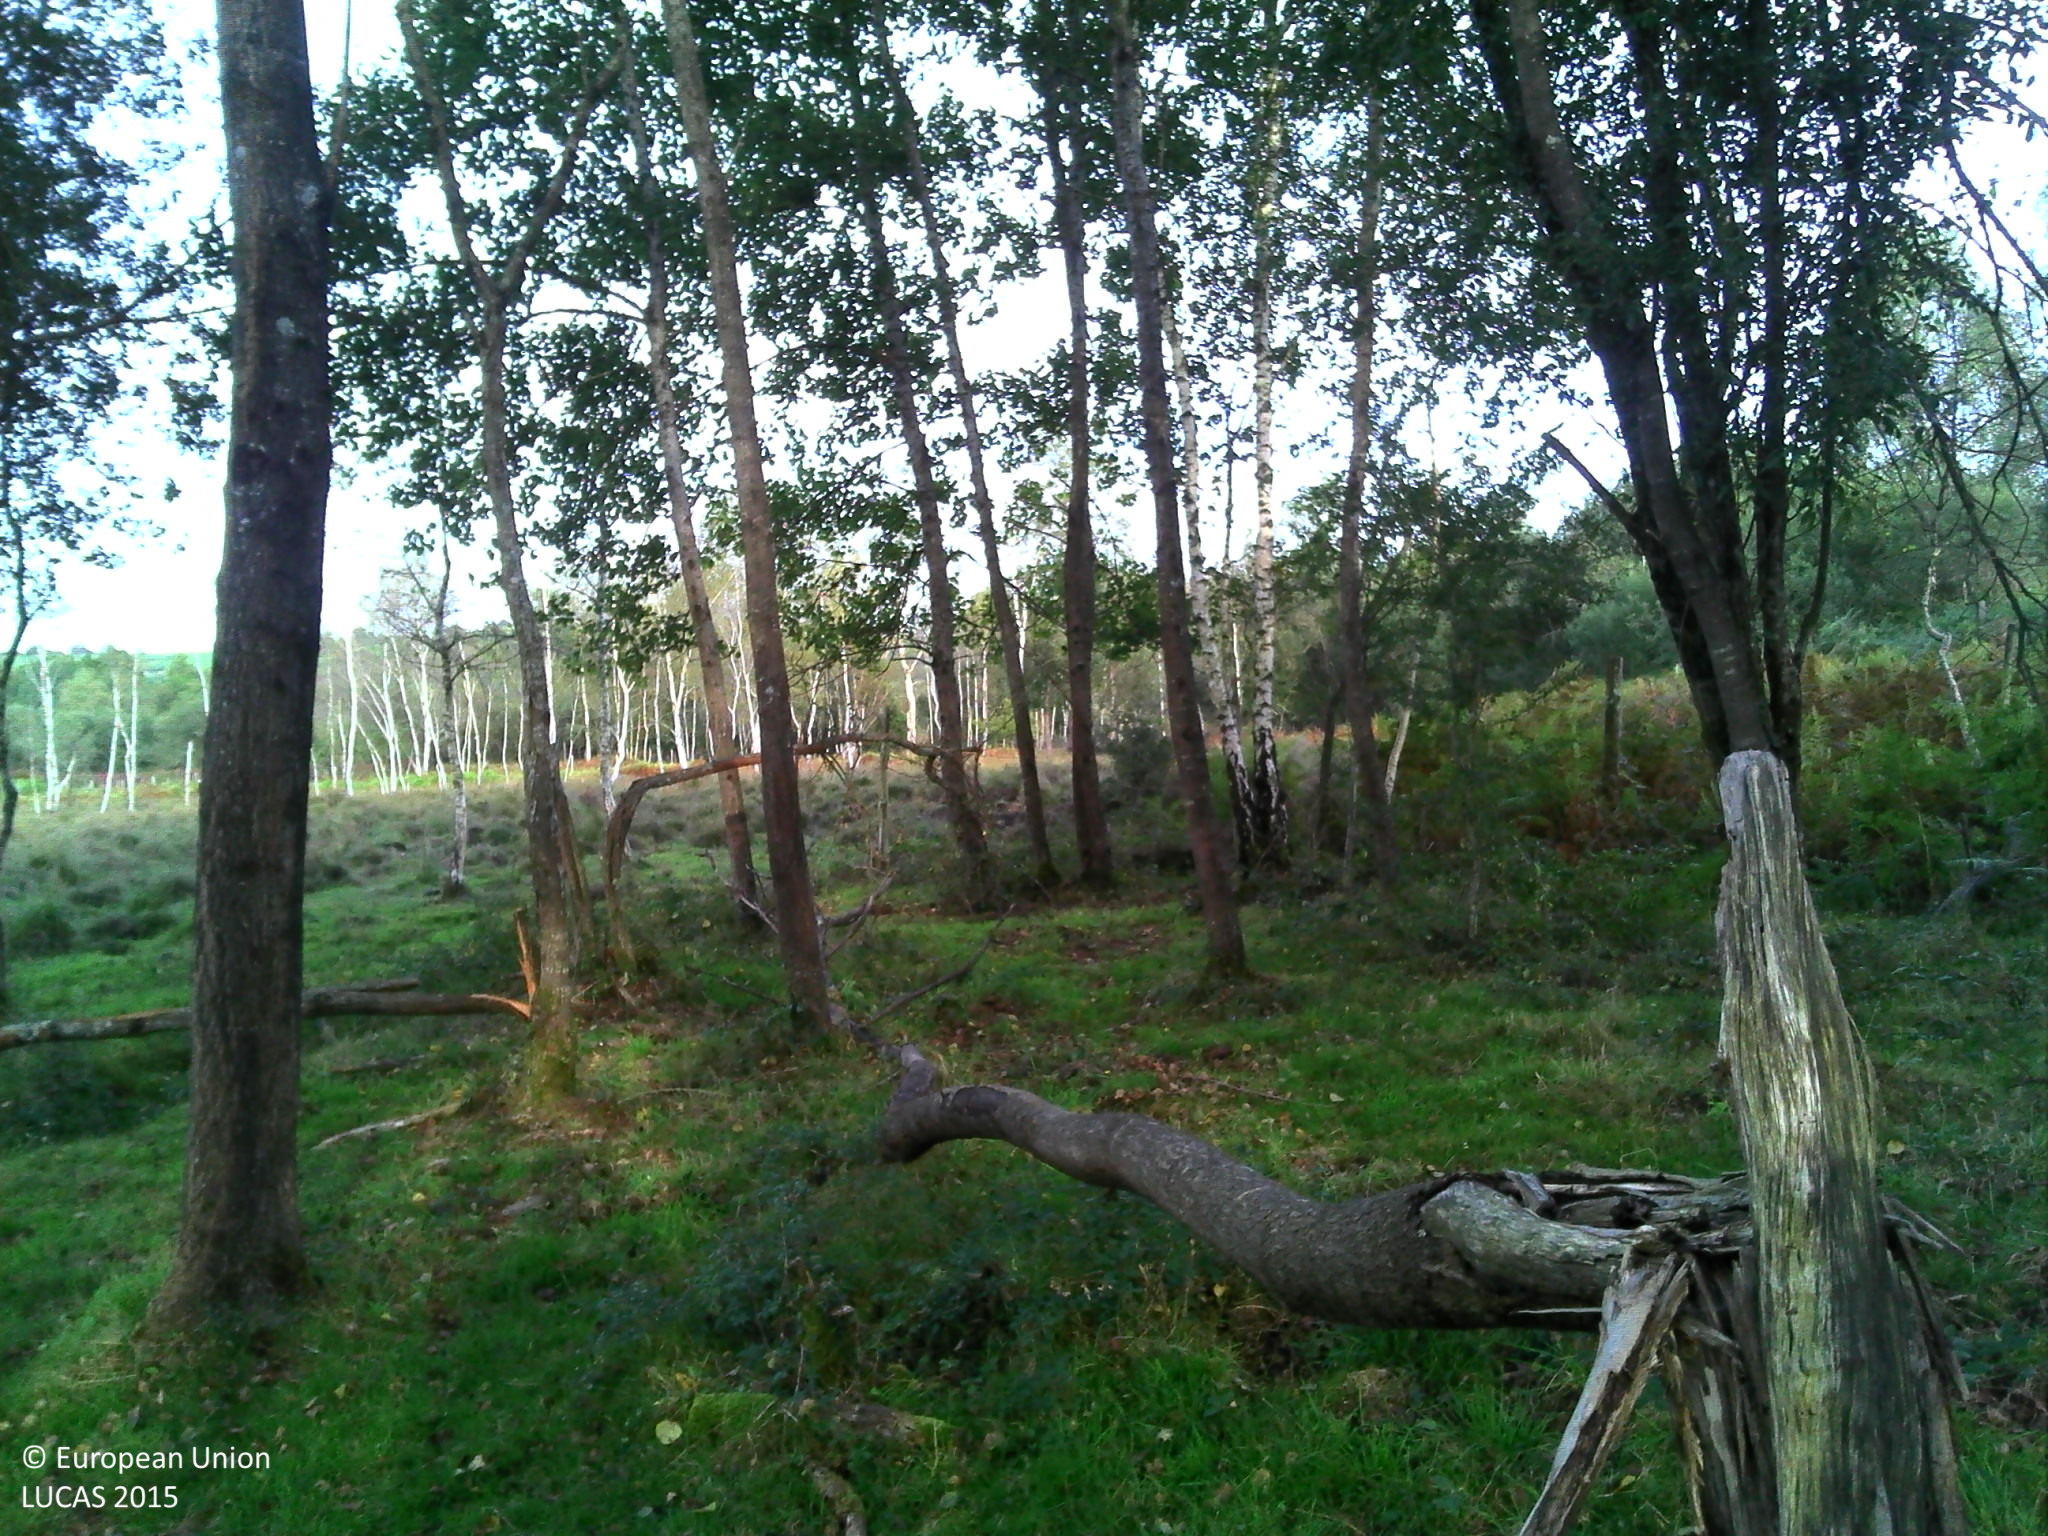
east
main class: Woodland
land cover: Broadleaved woodland
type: exotic forest
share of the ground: 50 - 75 %
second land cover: Grassland without tree/shrub cover
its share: > 75 %
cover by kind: broadleaved forest trees 55 %, herbaceous plants 40 %, lichens and mosses 5 %
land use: Forestry
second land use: Agriculture (excluding fallow land and kitchen gardens)
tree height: > 5 m
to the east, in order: Broadleaved woodland; Grassland without tree/shrub cover; Fences; Grassland without tree/shrub cover; Peatbogs; Broadleaved woodland; Peatbogs; Electric lines; Peatbogs; Single bushes/trees; Grassland without tree/shrub cover; Fences; Broadleaved woodland; Shrubland without tree cover; Fences; Shrubland with sparse tree cover
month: September
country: FR
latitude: 43.1493
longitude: -0.4461
